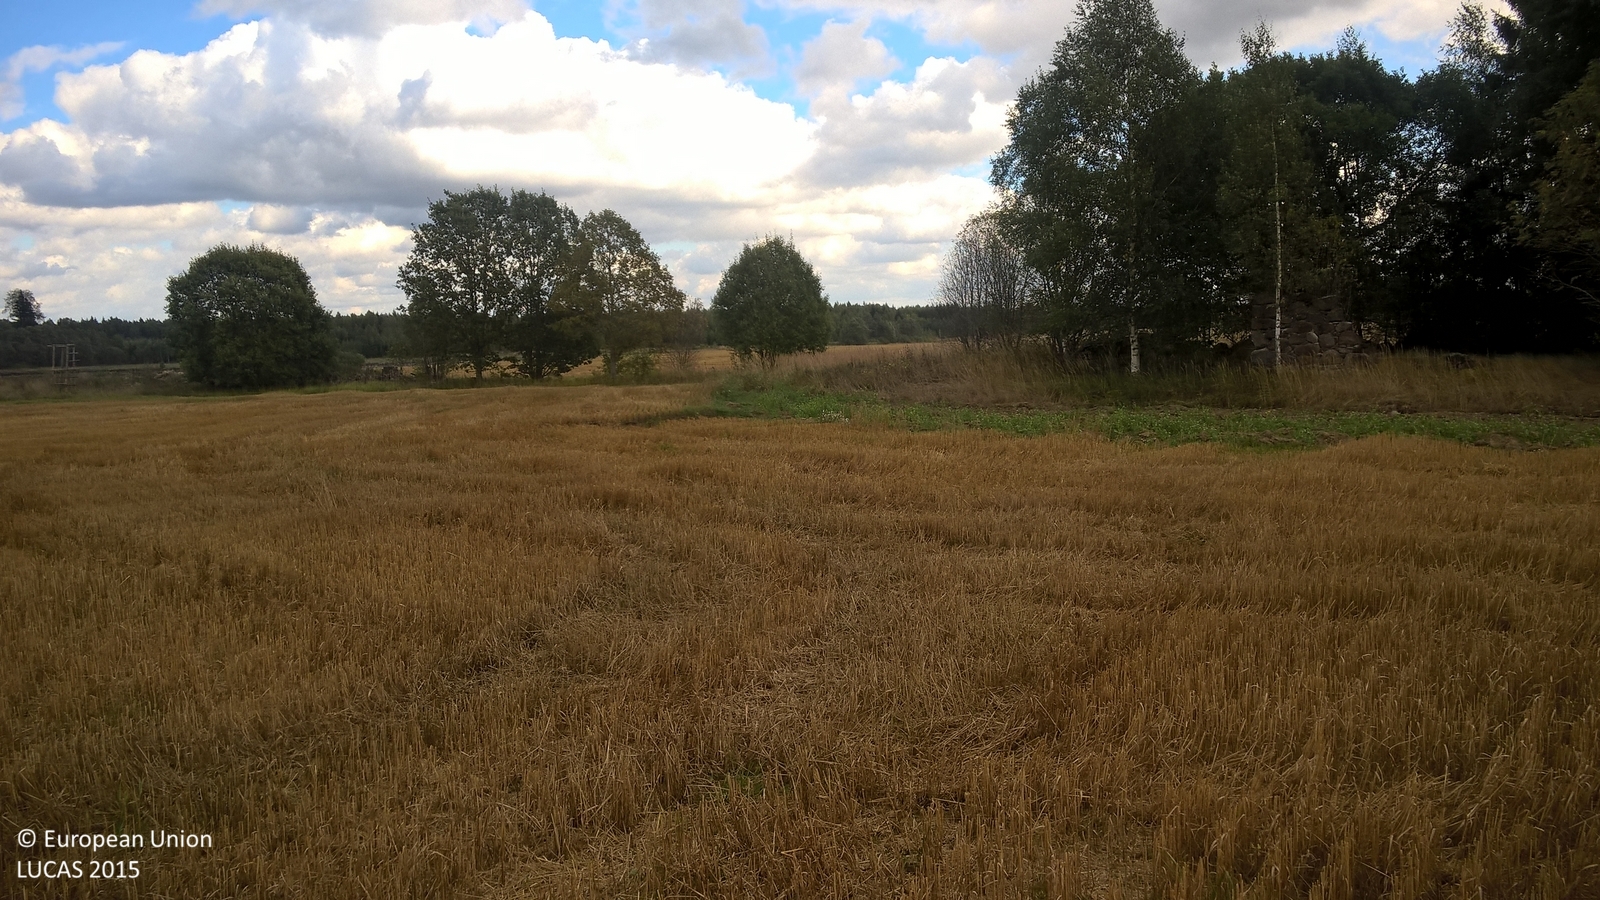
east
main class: Cropland
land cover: Common wheat
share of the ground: < 10 %
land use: Agriculture (excluding fallow land and kitchen gardens)
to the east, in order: Common wheat; Broadleaved woodland; Tracks; Spontaneously vegetated surfaces; Common wheat
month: September
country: LV
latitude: 57.6765
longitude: 25.5247
